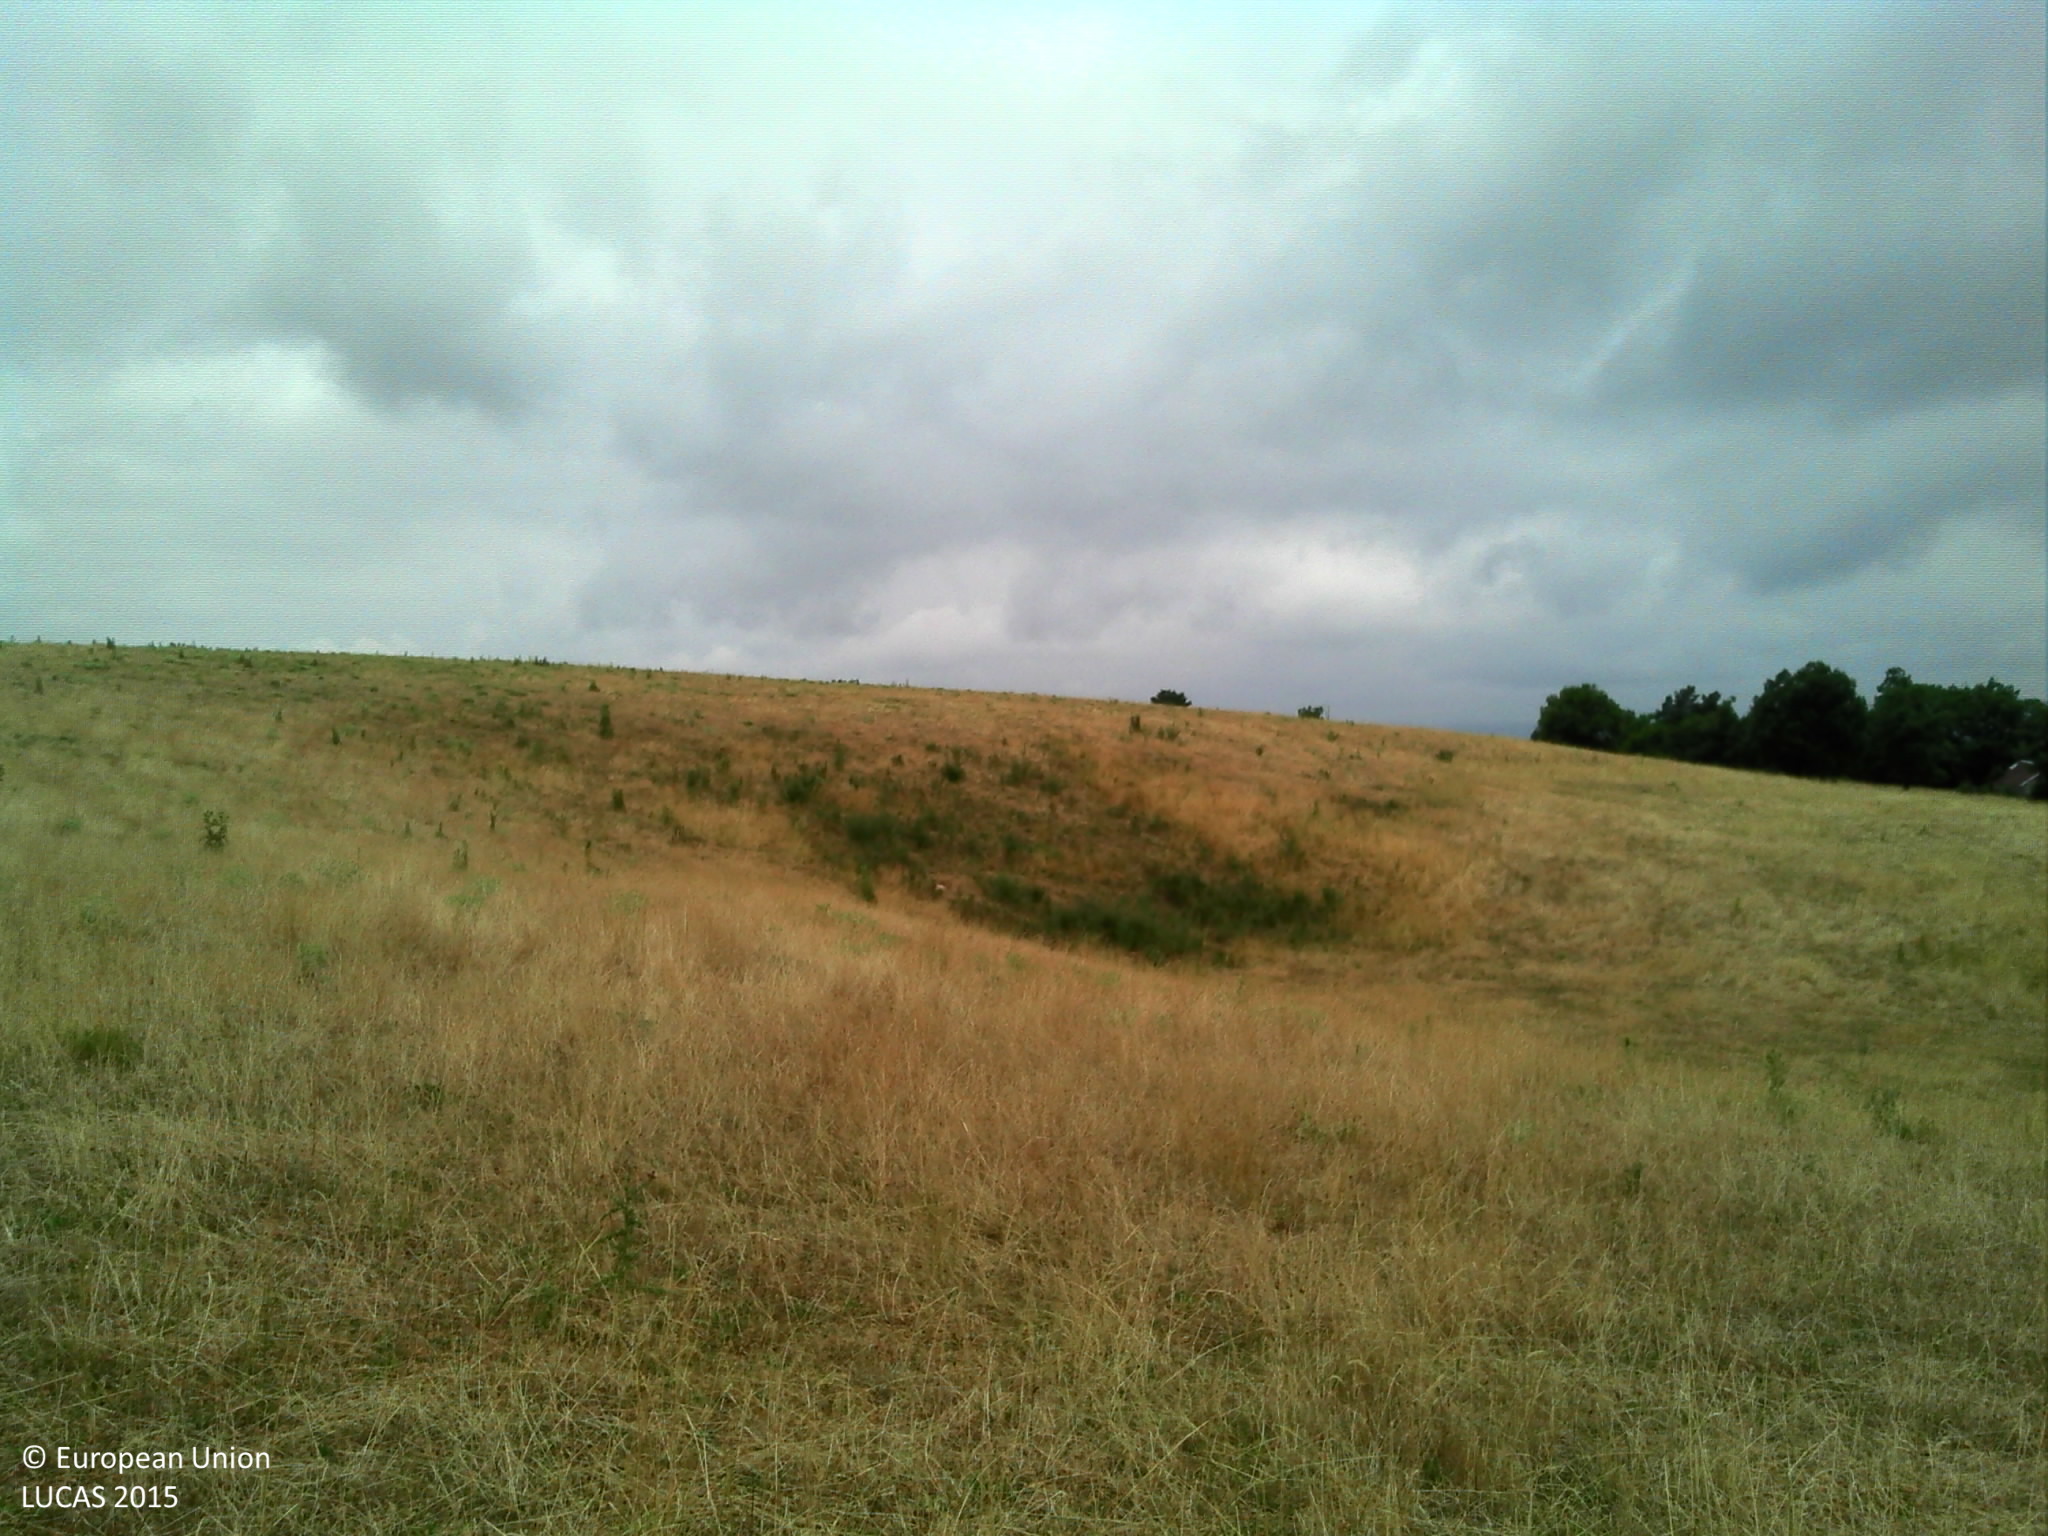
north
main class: Grassland
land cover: Grassland without tree/shrub cover
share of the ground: > 75 %
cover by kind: herbaceous plants 95 %, shrubs 5 %
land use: Agriculture (excluding fallow land and kitchen gardens)
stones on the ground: 25 - 50 %
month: July
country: FR
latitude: 44.4076
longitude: 3.0605
